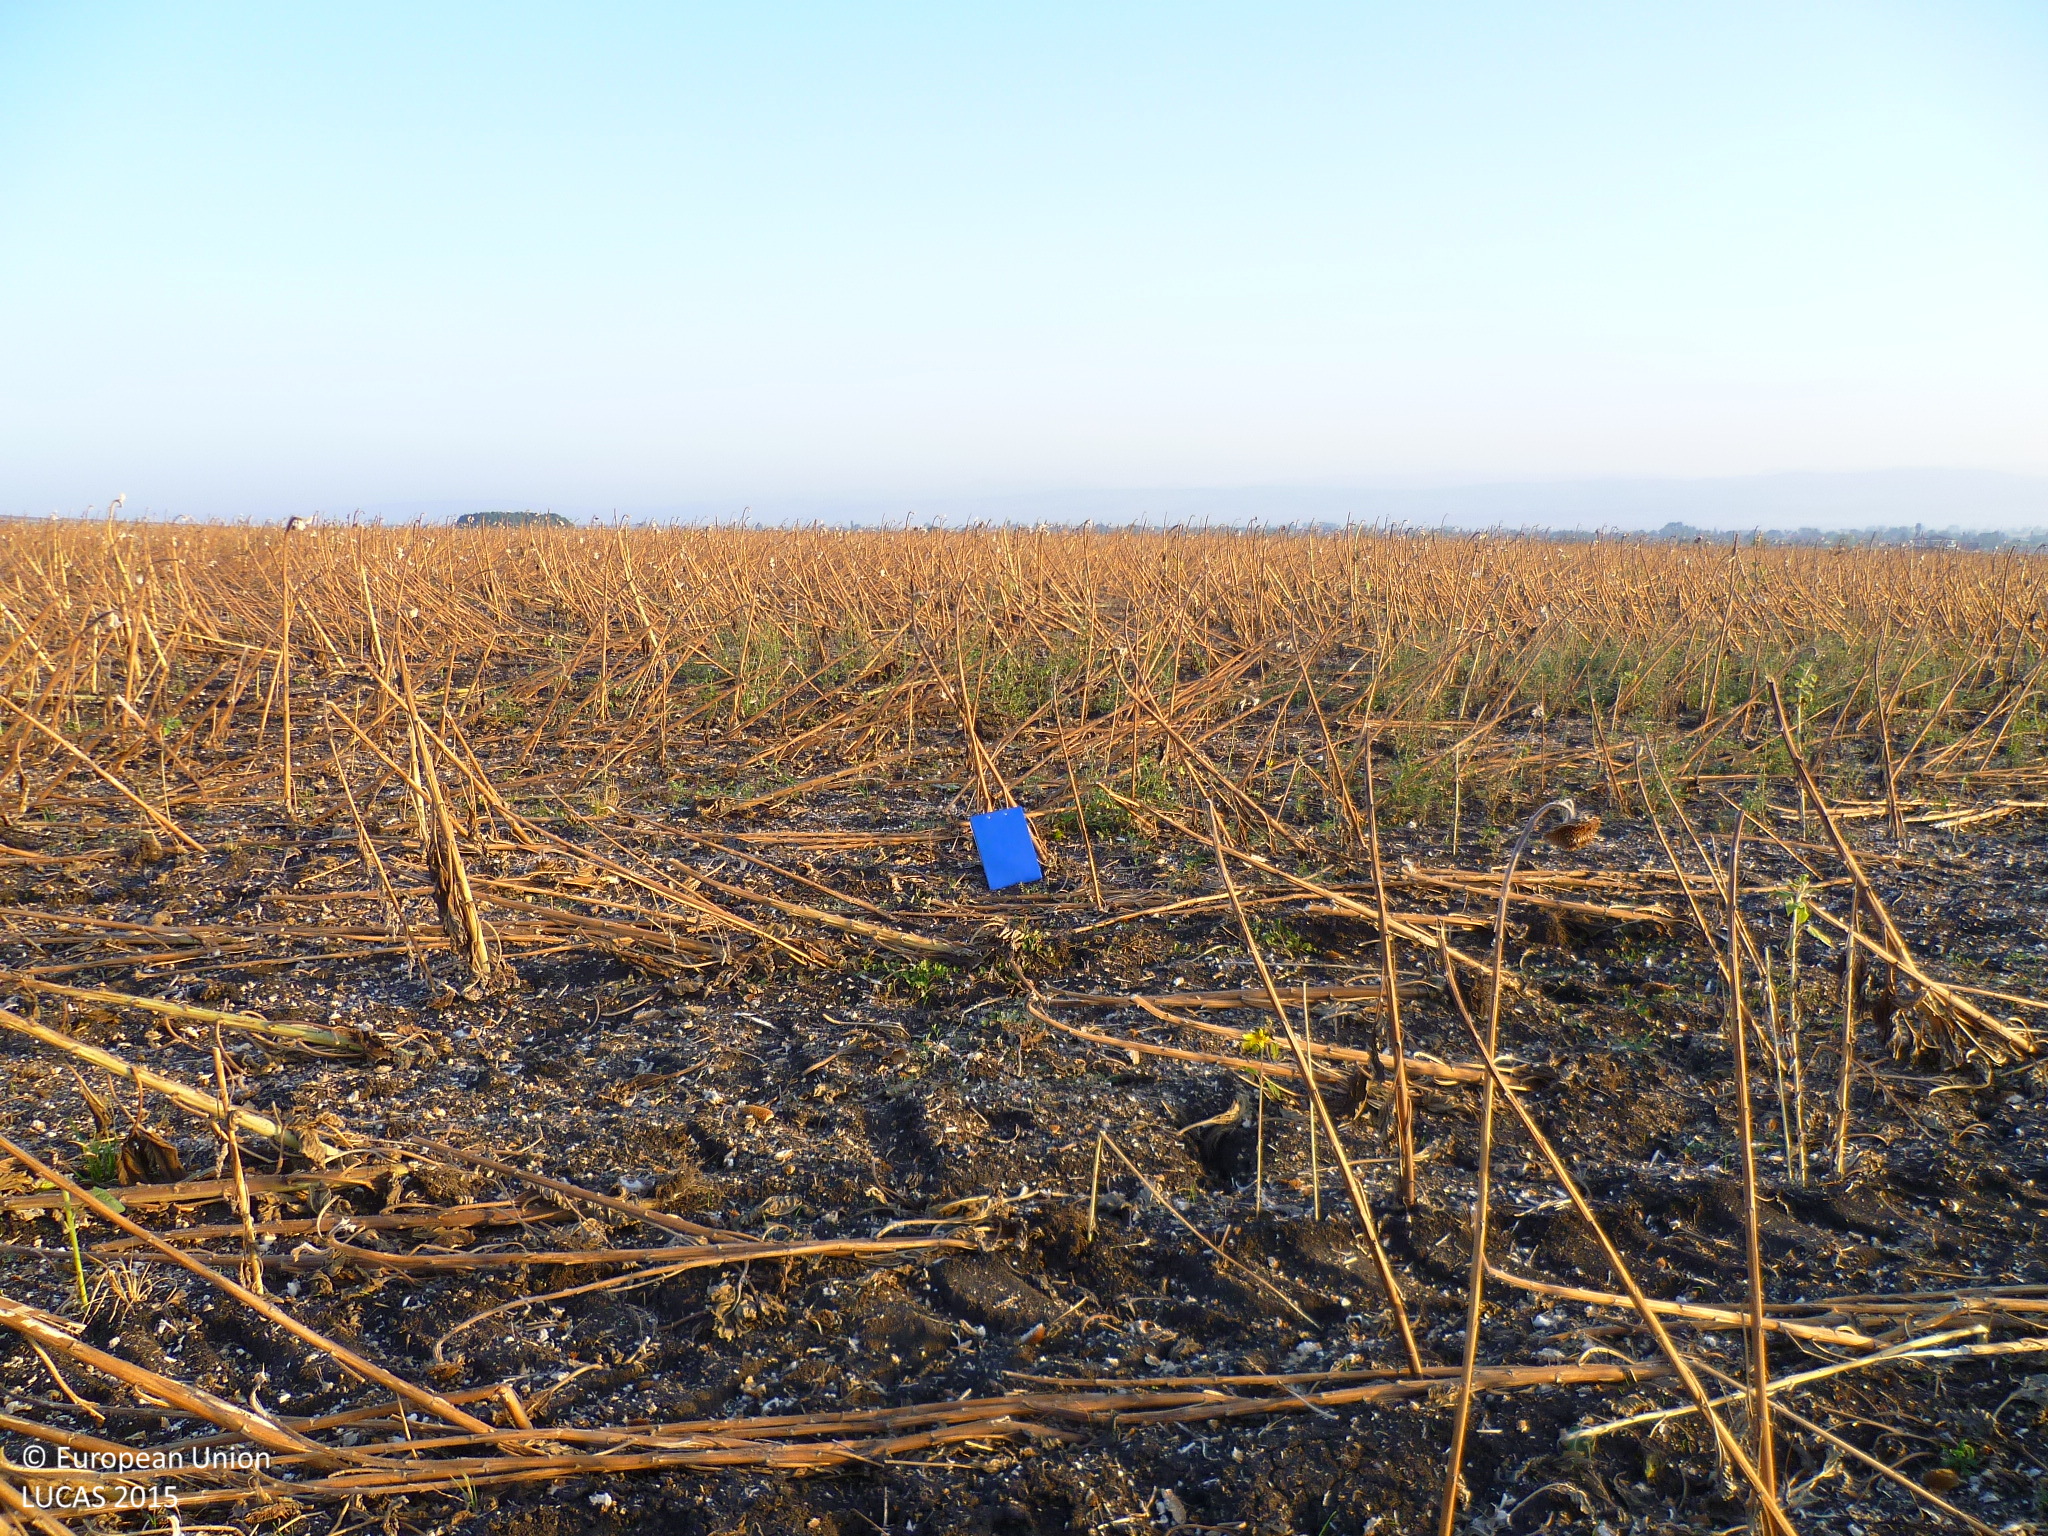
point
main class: Cropland
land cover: Sunflower
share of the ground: 25 - 50 %
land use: Agriculture (excluding fallow land and kitchen gardens)
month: September
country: BG
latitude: 42.7617
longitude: 23.1440
